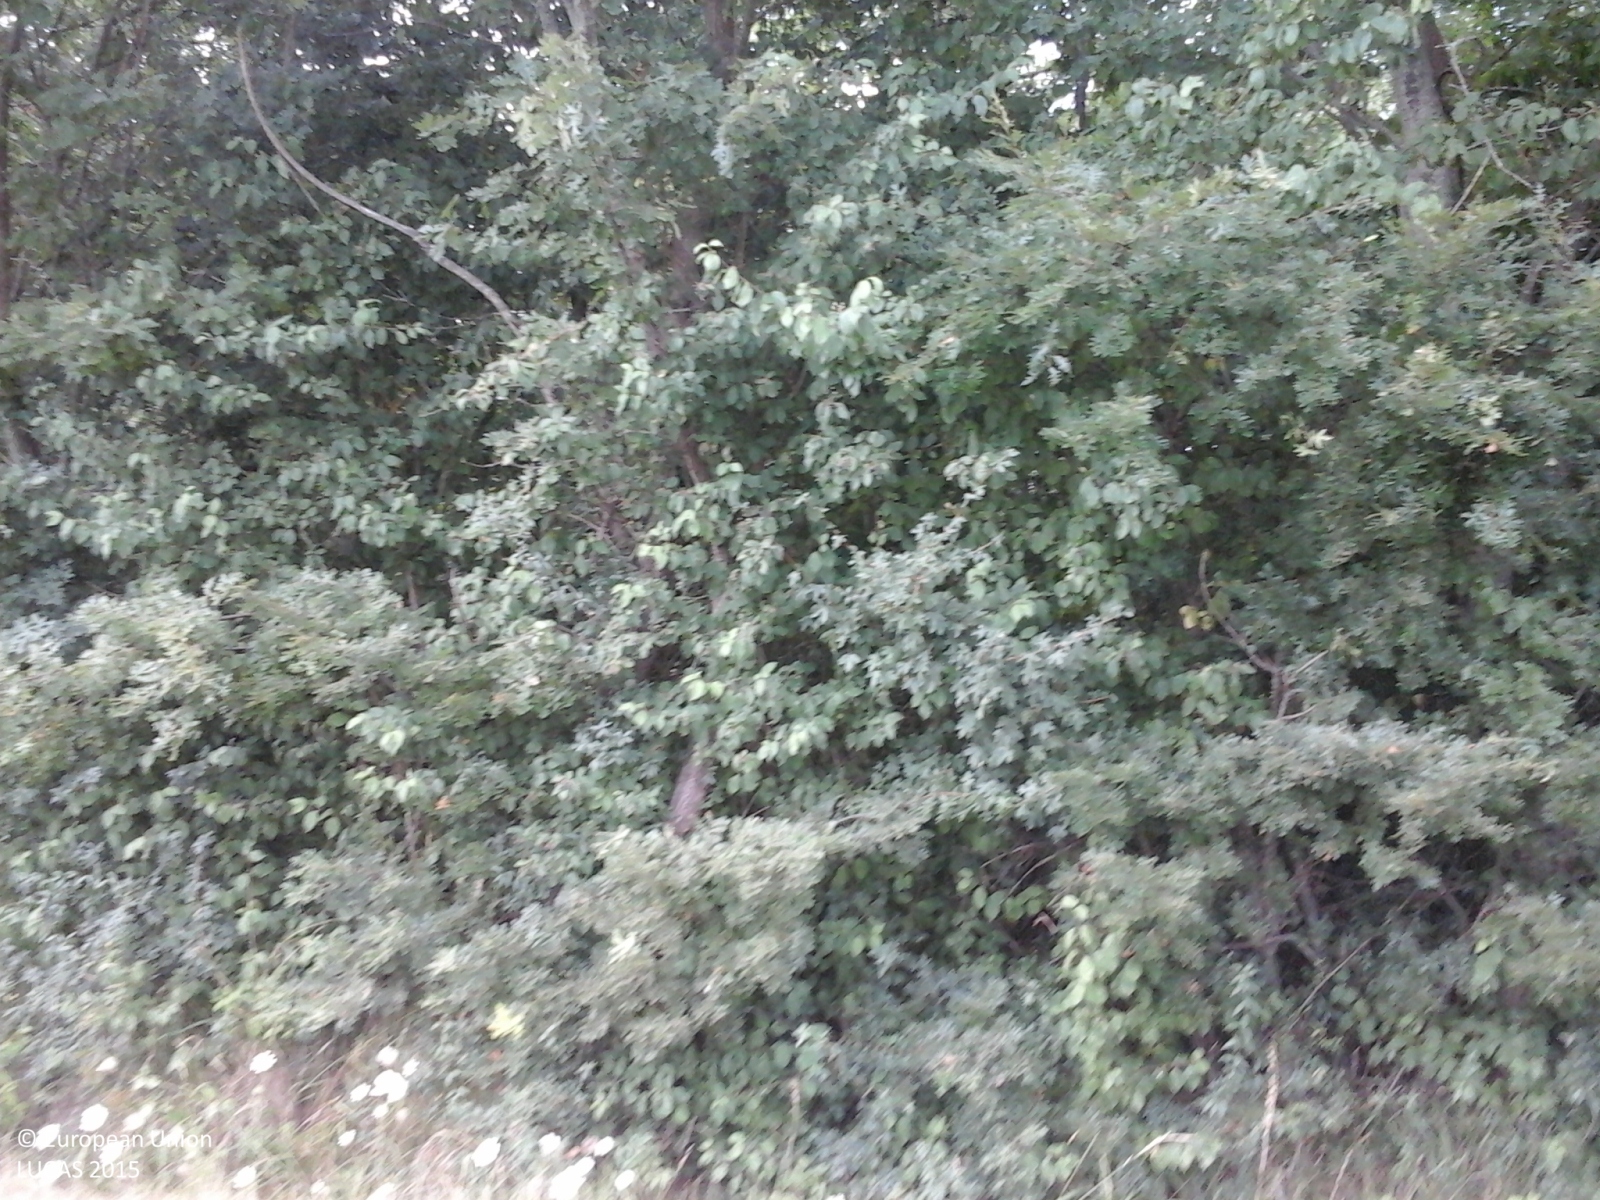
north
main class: Cropland
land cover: Dry pulses
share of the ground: > 75 %
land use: Agriculture (excluding fallow land and kitchen gardens)
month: July
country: IT
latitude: 43.1532
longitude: 11.1402
